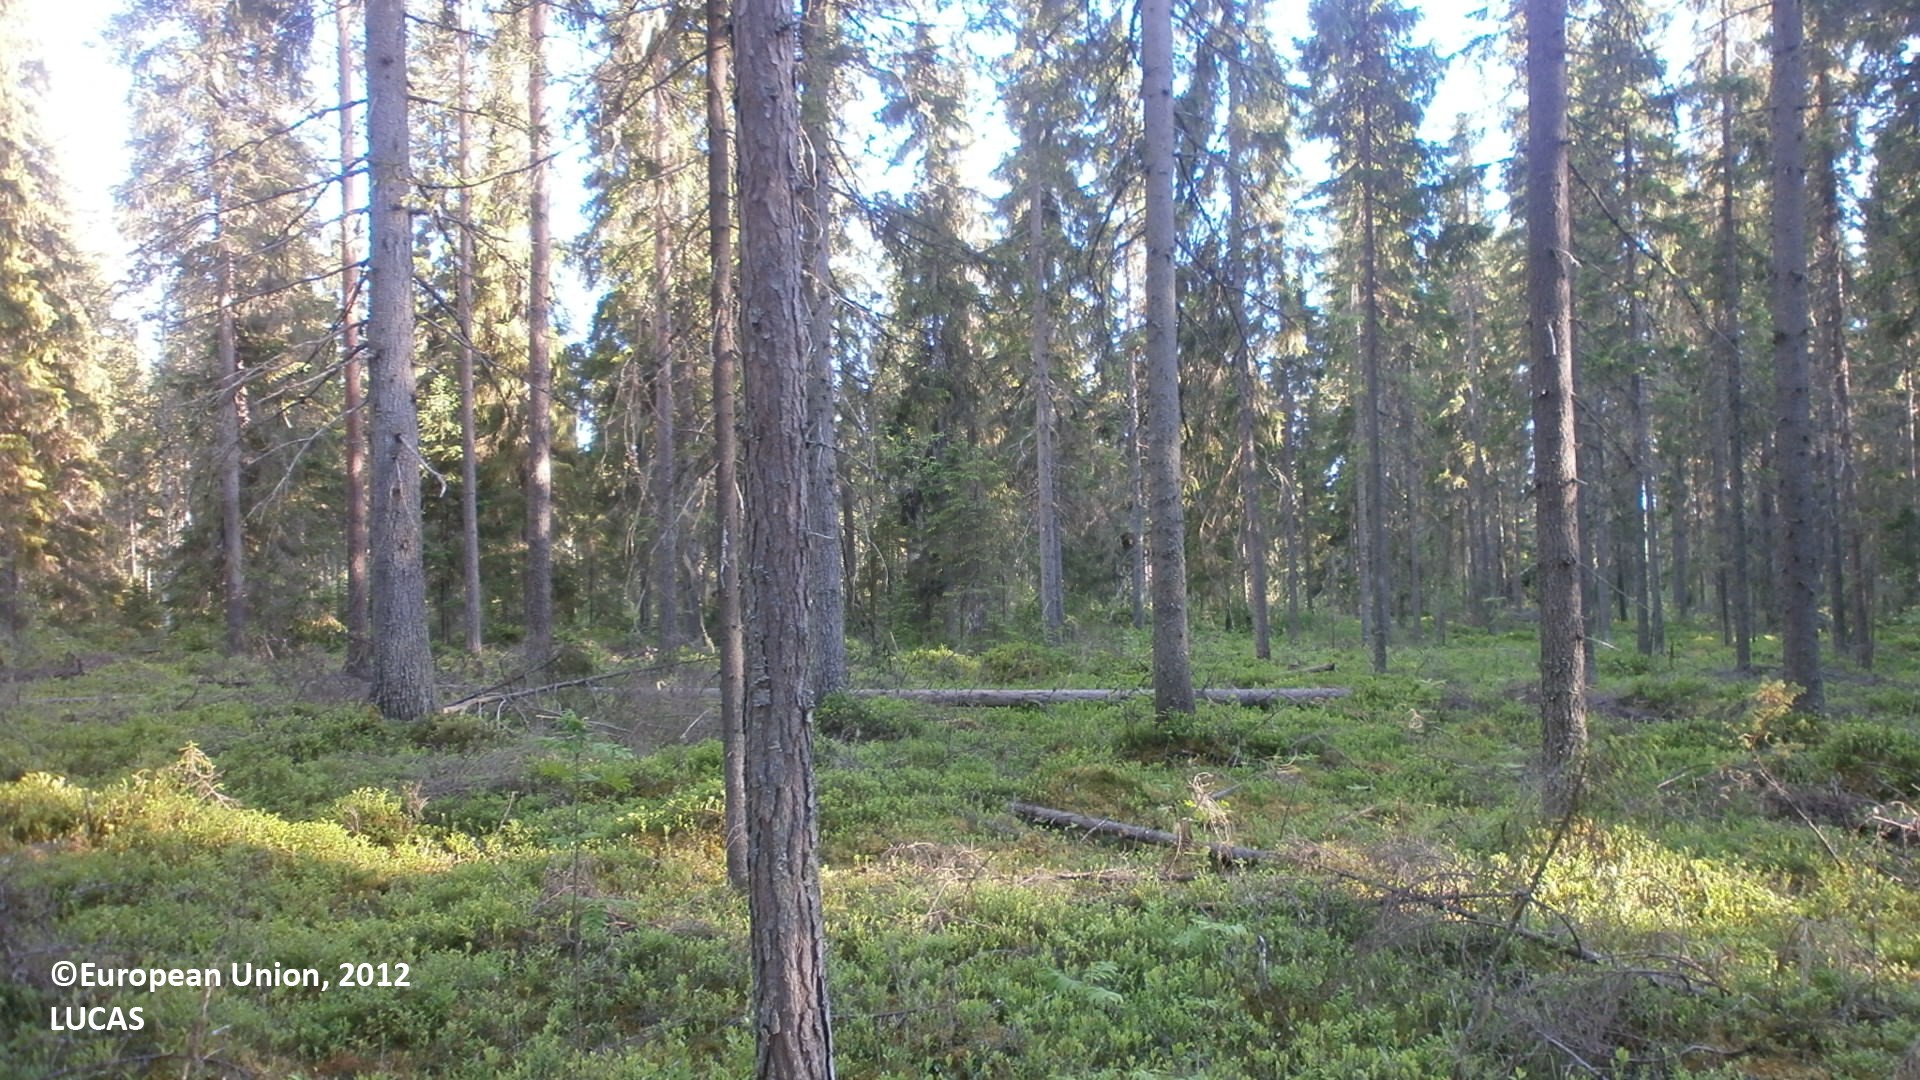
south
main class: Woodland
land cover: Spruce dominated coniferous woodland
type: boreal forest
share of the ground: 25 - 50 %
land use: Forestry
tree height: > 5 m
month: June
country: FI
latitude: 64.3258
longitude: 24.9963
